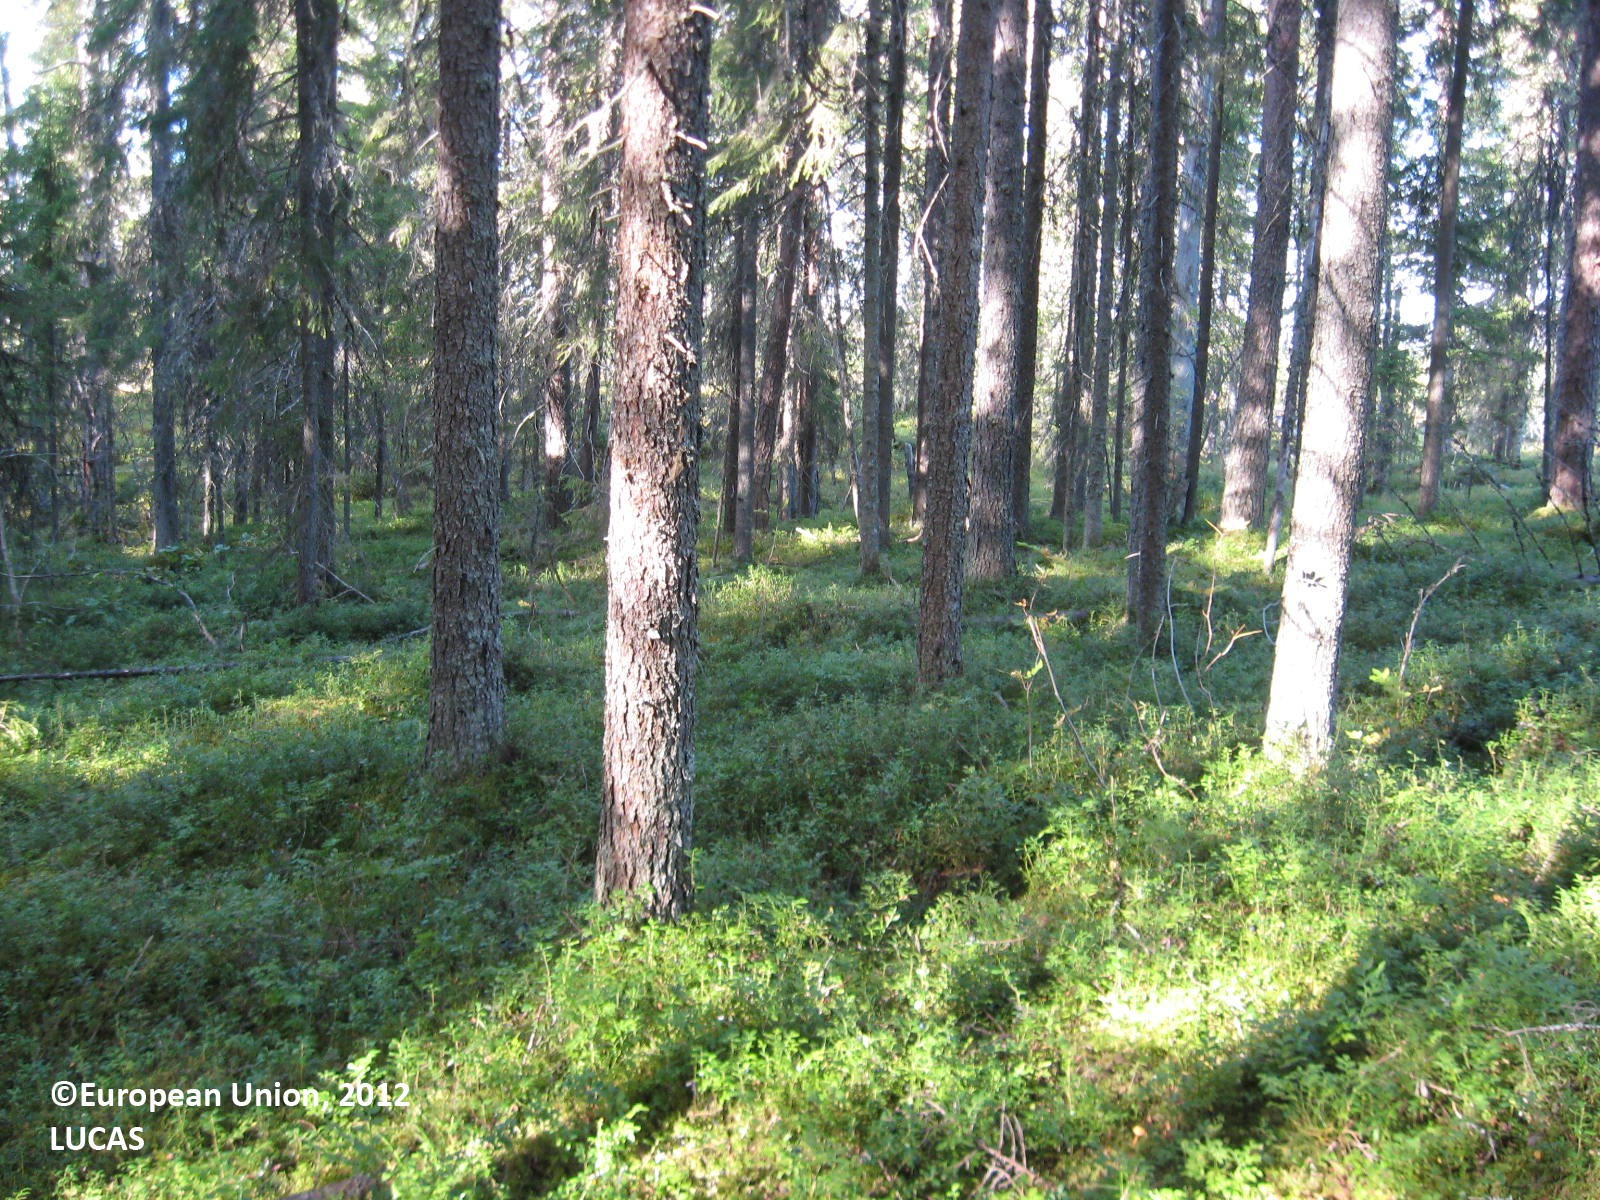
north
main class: Woodland
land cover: Spruce dominated coniferous woodland
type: boreal forest
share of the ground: > 75 %
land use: Forestry
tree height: > 5 m
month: August
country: FI
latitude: 63.8606
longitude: 30.0825
